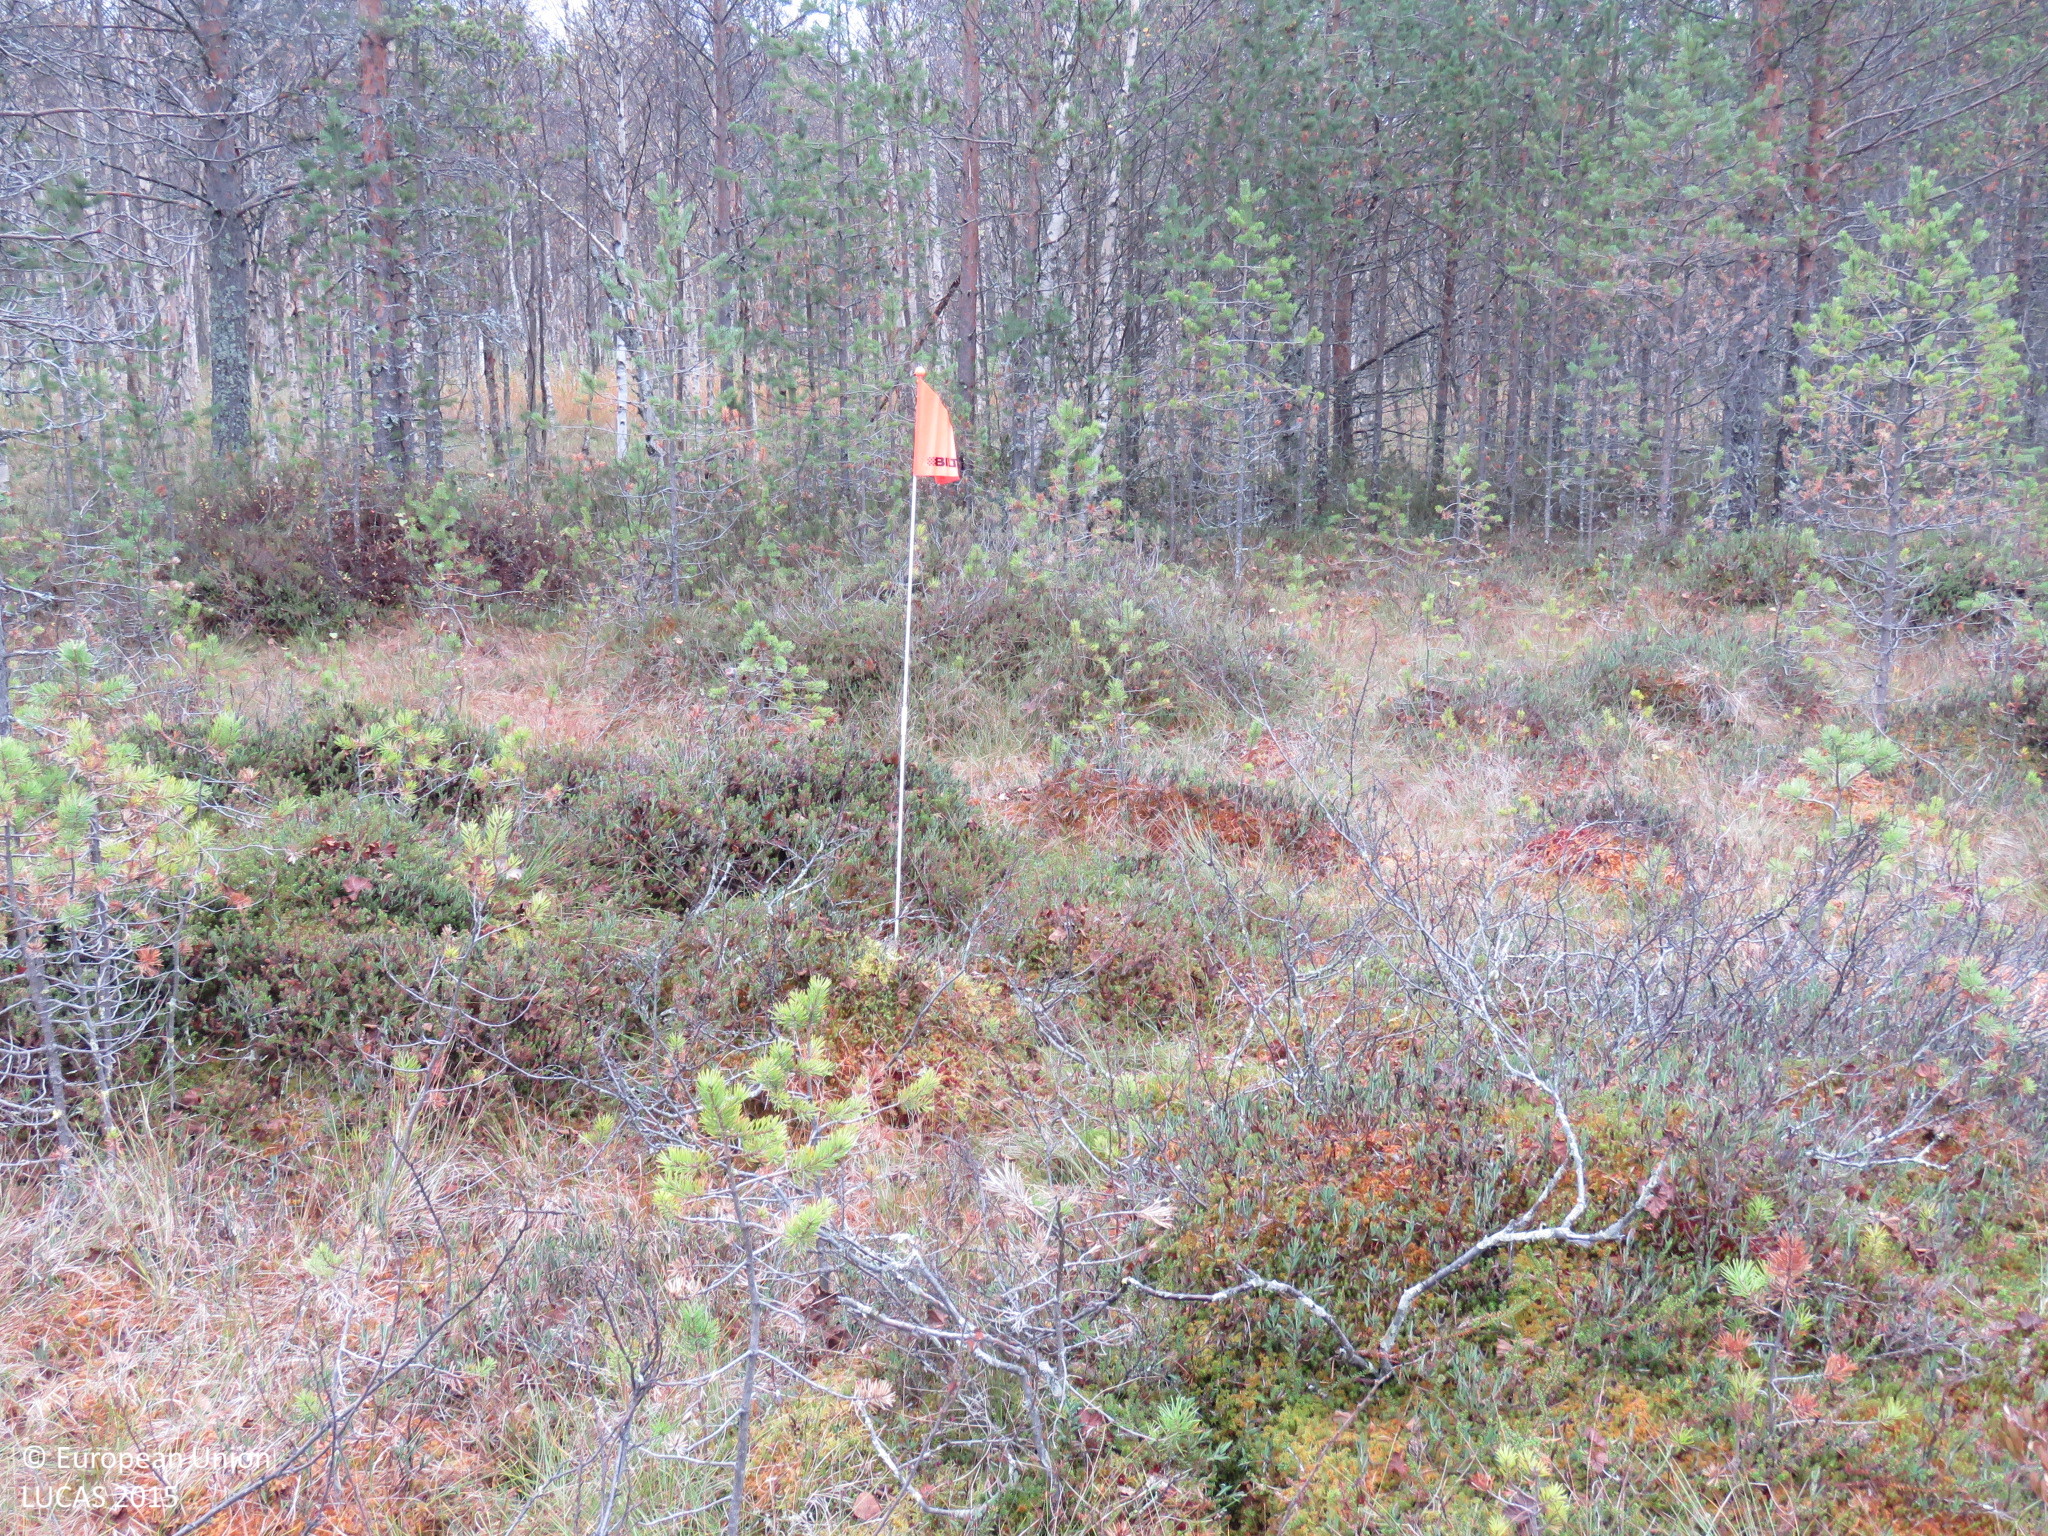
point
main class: Woodland
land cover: Pine dominated coniferous woodland
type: mire and swamp forests
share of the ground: 25 - 50 %
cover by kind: coniferous forest trees 45 %, shrubs 25 %, herbaceous plants 20 %, lichens and mosses 10 %
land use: Forestry
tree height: < 5 m
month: September
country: FI
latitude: 65.2751
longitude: 26.8043
